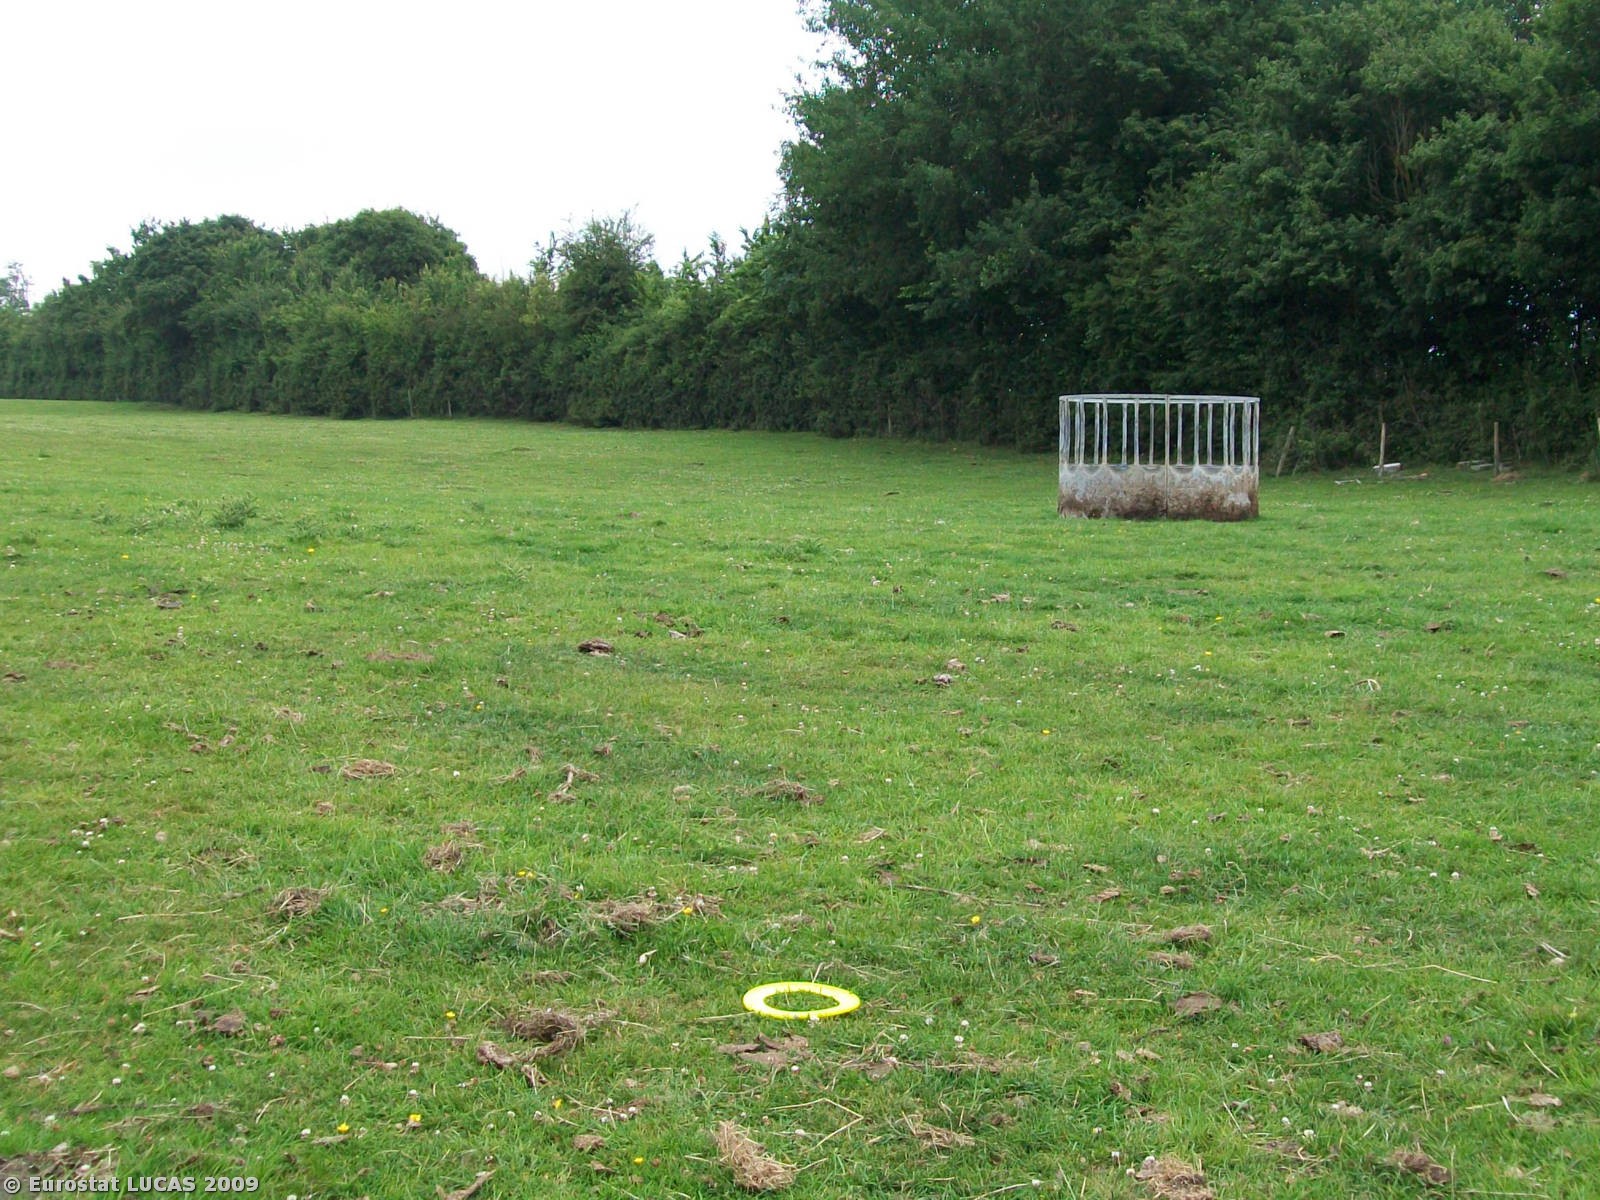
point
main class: Grassland
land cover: Grassland without tree/shrub cover
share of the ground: > 75 %
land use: Agriculture (excluding fallow land and kitchen gardens)
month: June
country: GB
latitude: 51.3192
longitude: -2.2734
